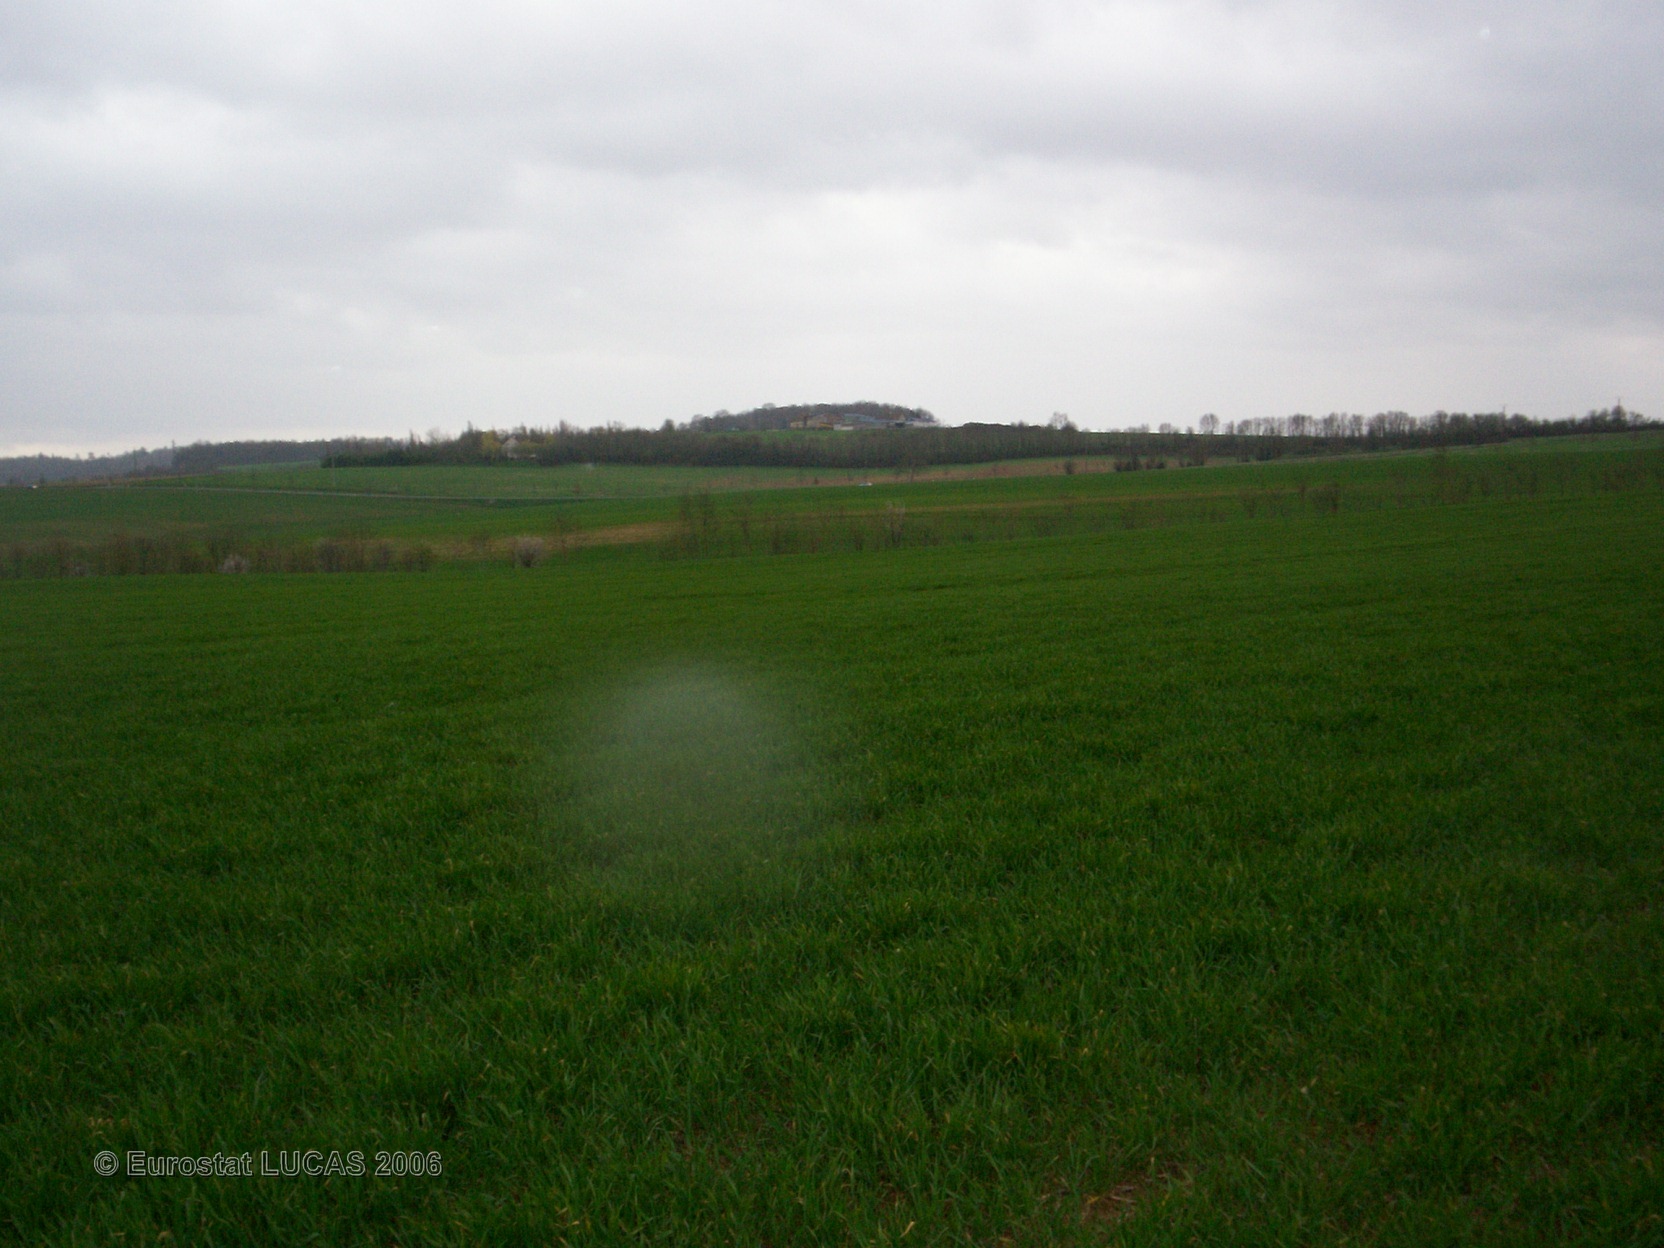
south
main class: Cropland
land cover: Common wheat
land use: Agriculture (excluding fallow land and kitchen gardens)
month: April
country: FR
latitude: 48.3587
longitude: 0.3241
